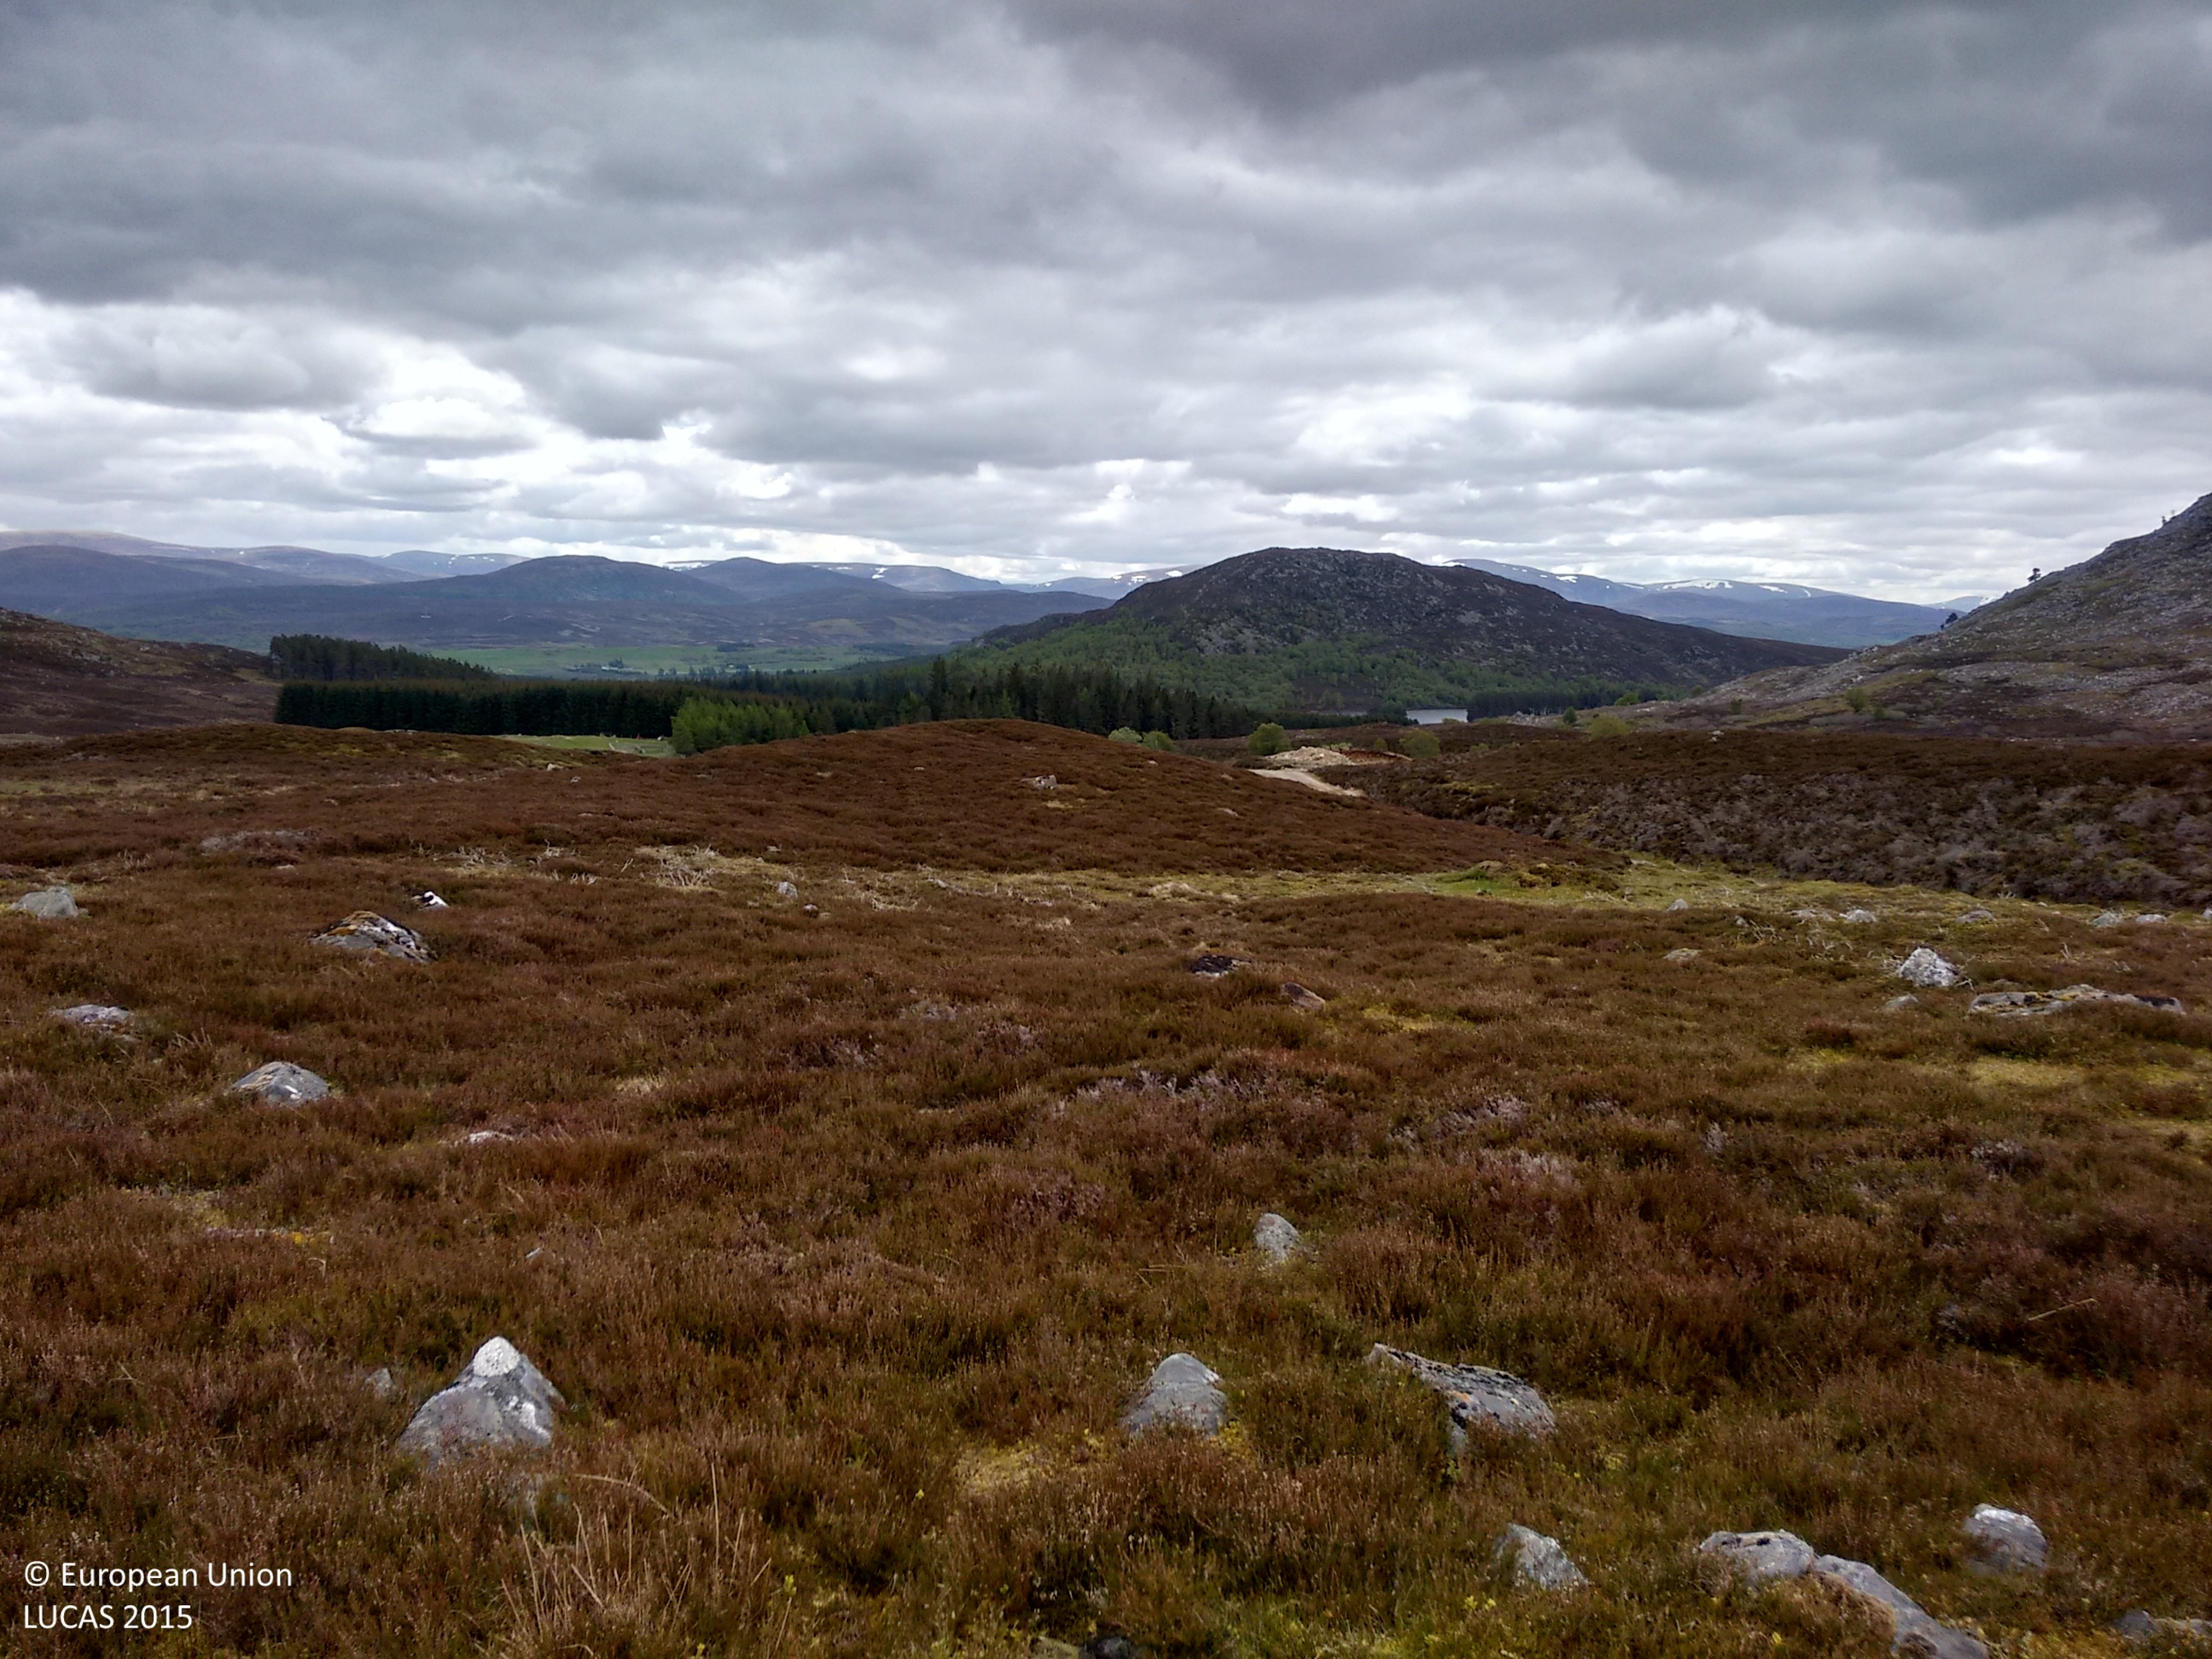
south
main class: Shrubland
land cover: Shrubland without tree cover
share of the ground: > 75 %
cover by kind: shrubs 90 %, lichens and mosses 5 %
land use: Agriculture (excluding fallow land and kitchen gardens)
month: June
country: GB
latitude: 57.1083
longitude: -4.0683
